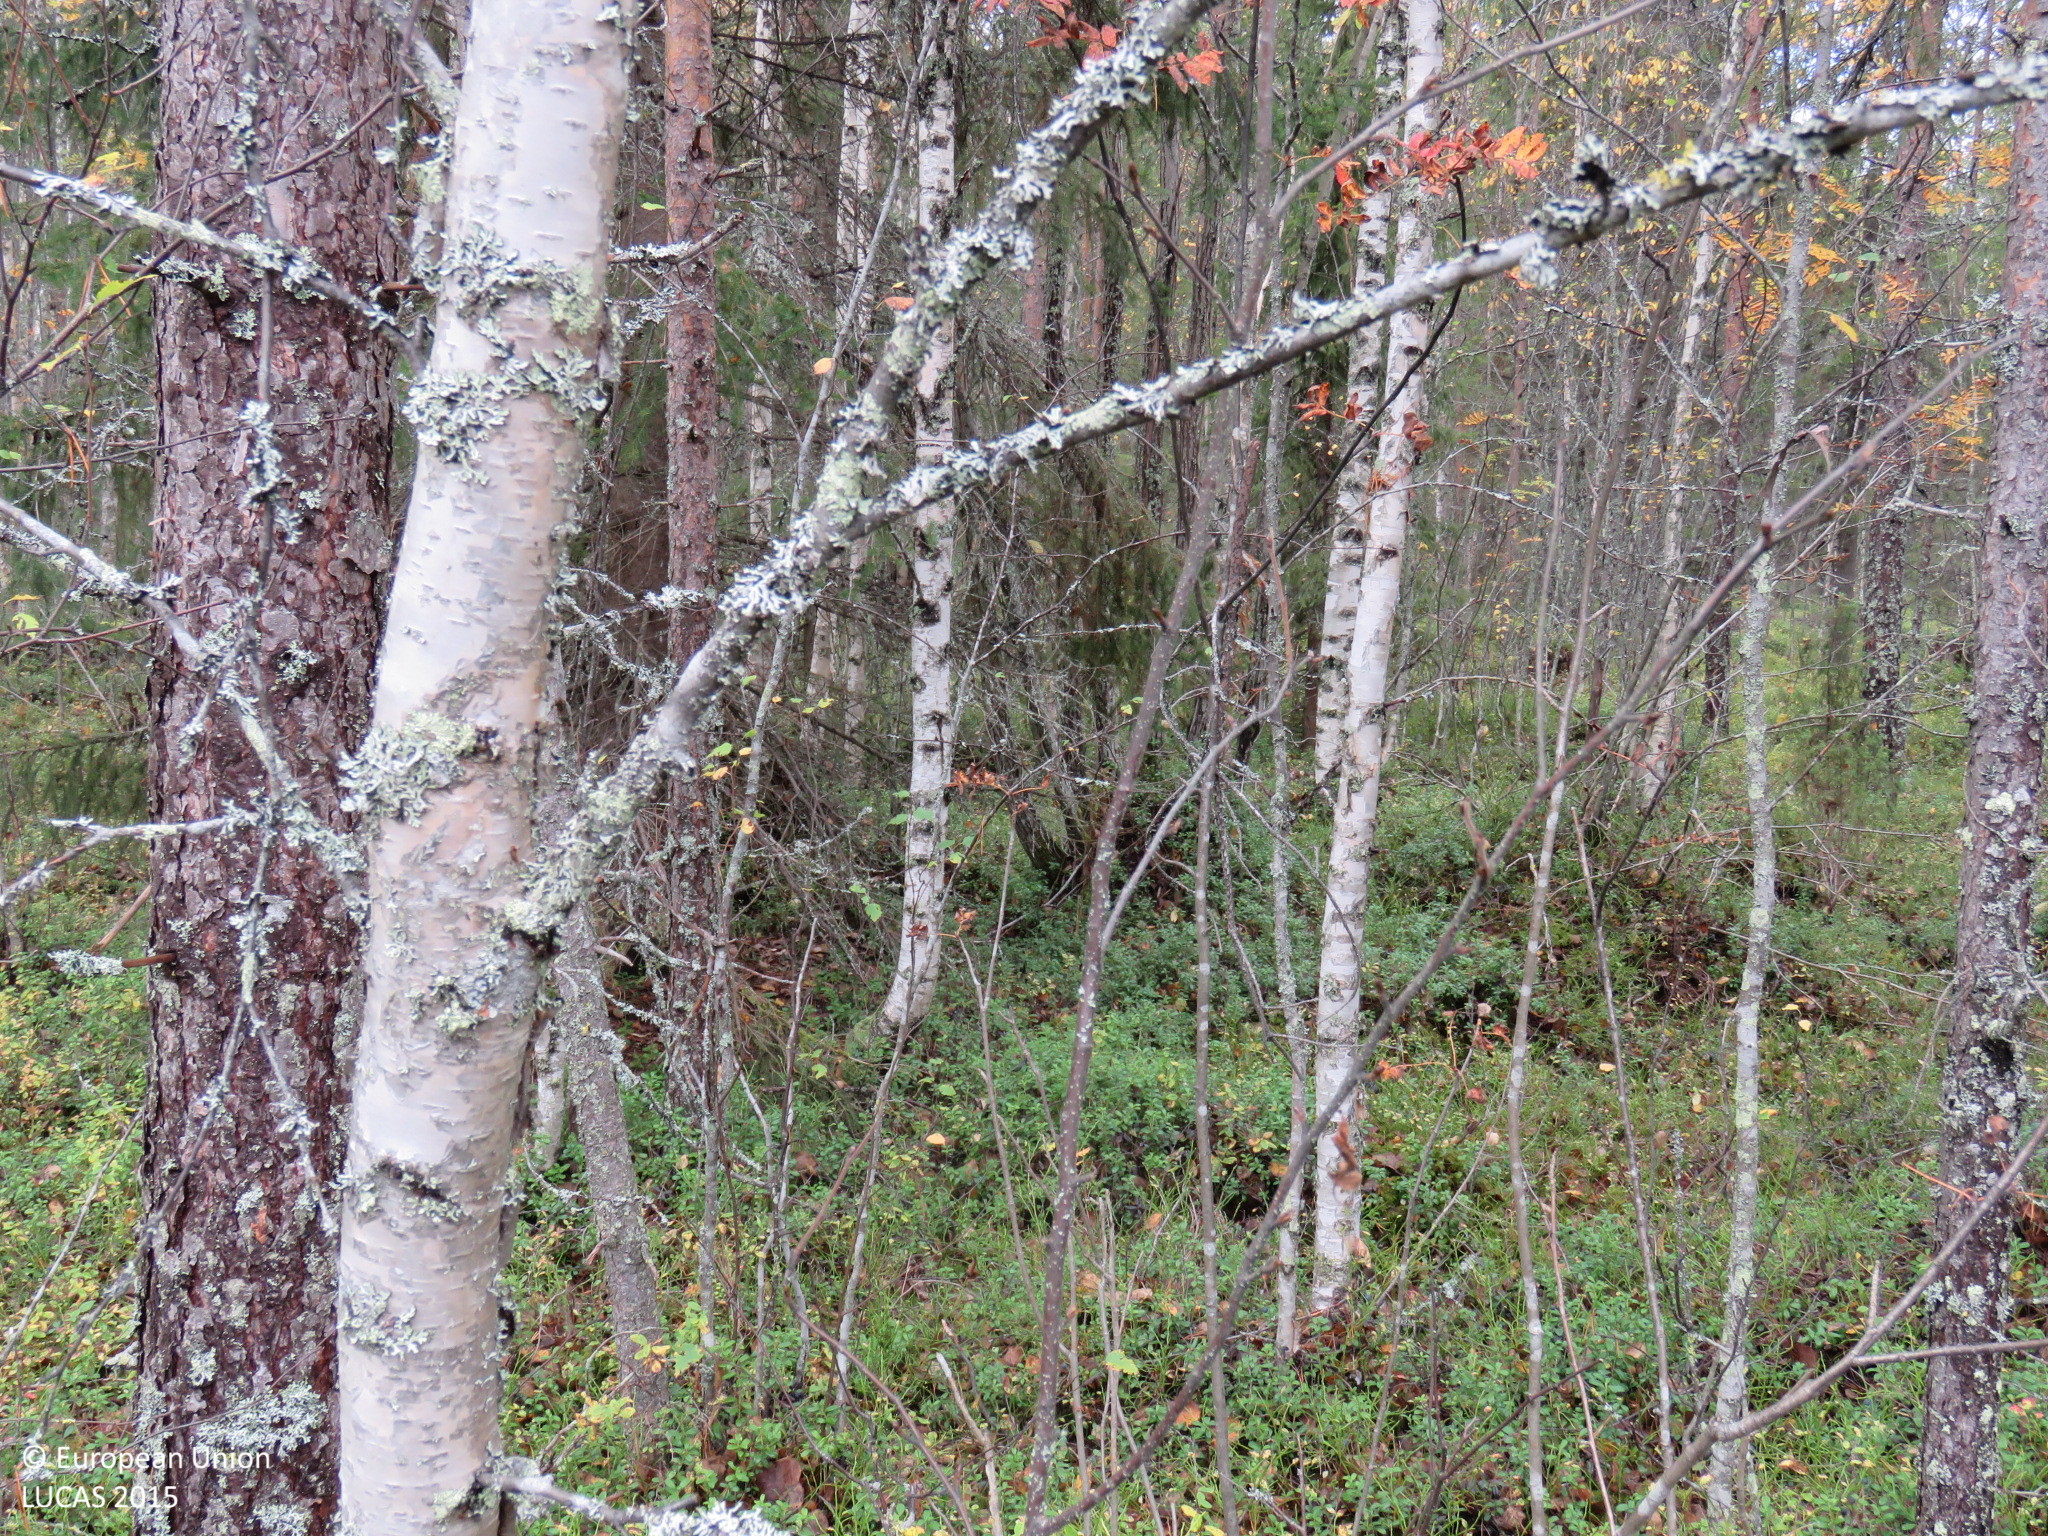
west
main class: Woodland
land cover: Pine dominated mixed woodland
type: boreal forest
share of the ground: > 75 %
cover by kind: broadleaved forest trees 45 %, coniferous forest trees 40 %, shrubs 15 %
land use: Forestry
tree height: > 5 m
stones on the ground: < 10 %
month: September
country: FI
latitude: 65.0660
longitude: 27.0224
